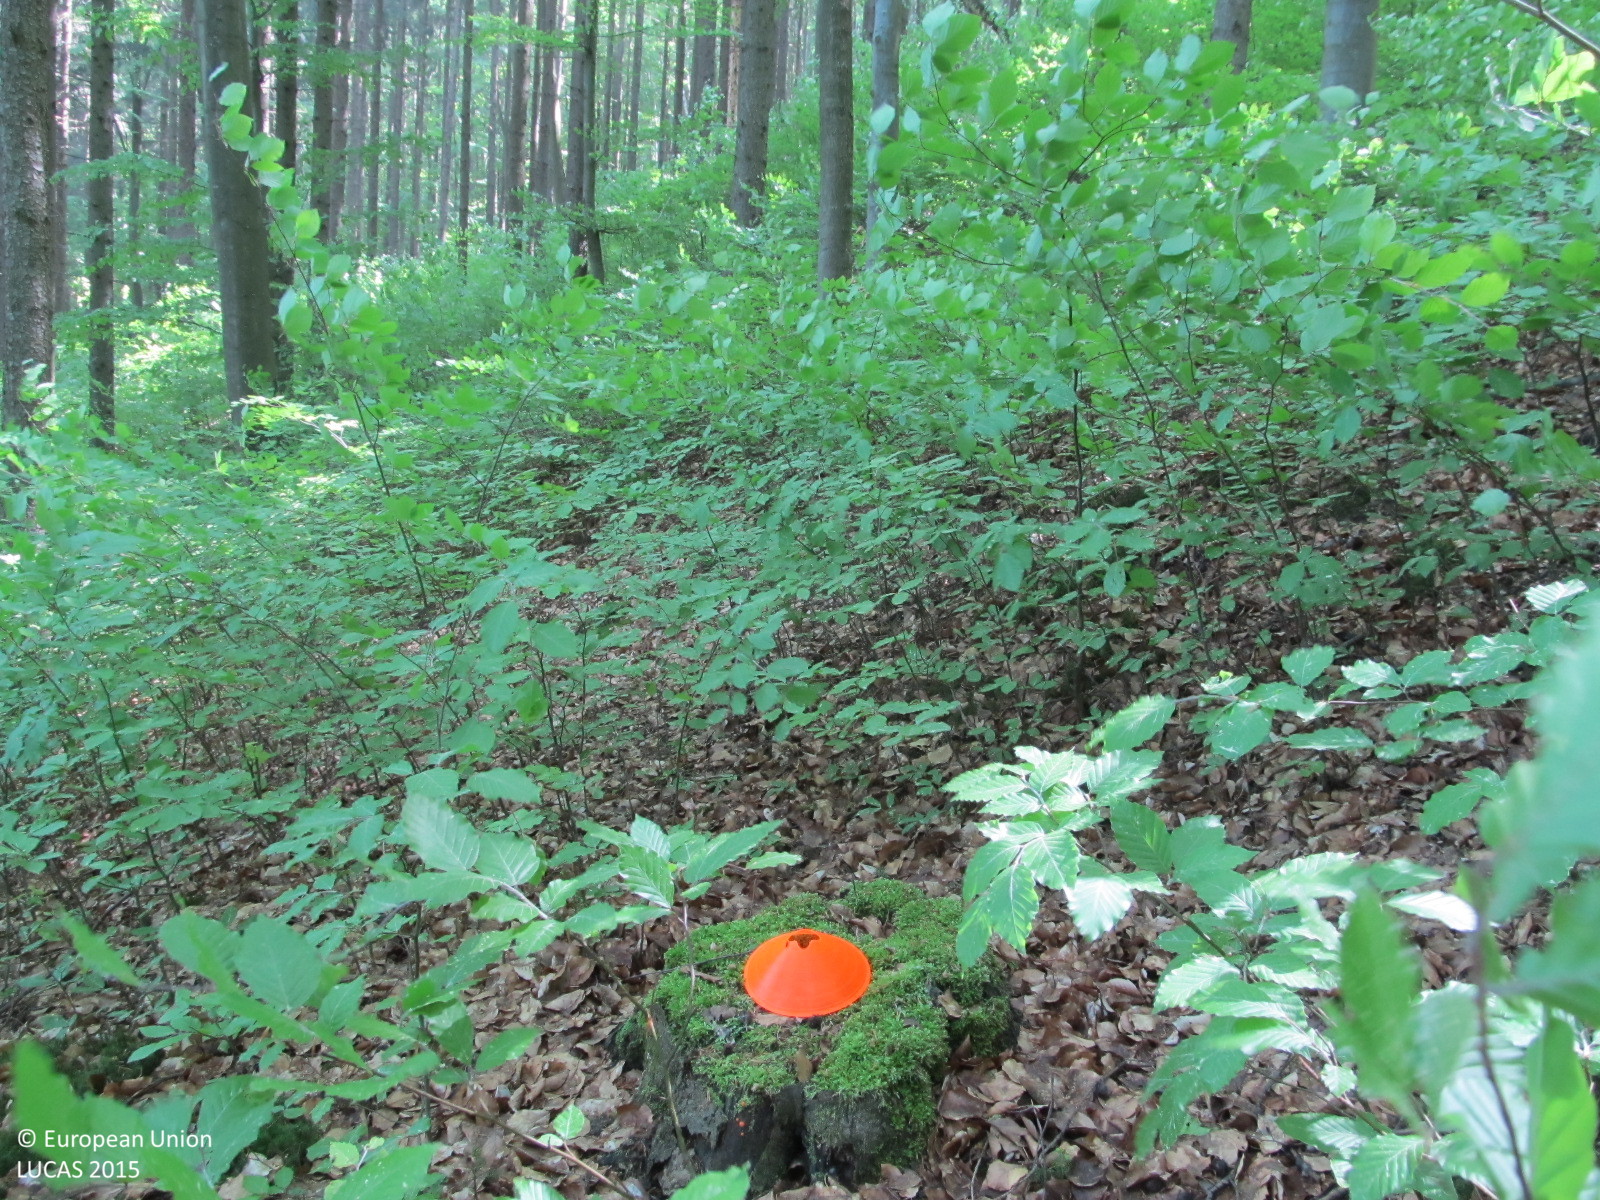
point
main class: Woodland
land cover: Broadleaved woodland
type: beech forest
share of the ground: > 75 %
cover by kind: broadleaved forest trees 60 %, coniferous forest trees 20 %, shrubs 10 %, unconsolidated bare surface 10 %
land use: Forestry
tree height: > 5 m
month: May
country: AT
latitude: 48.6081
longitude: 15.5229
